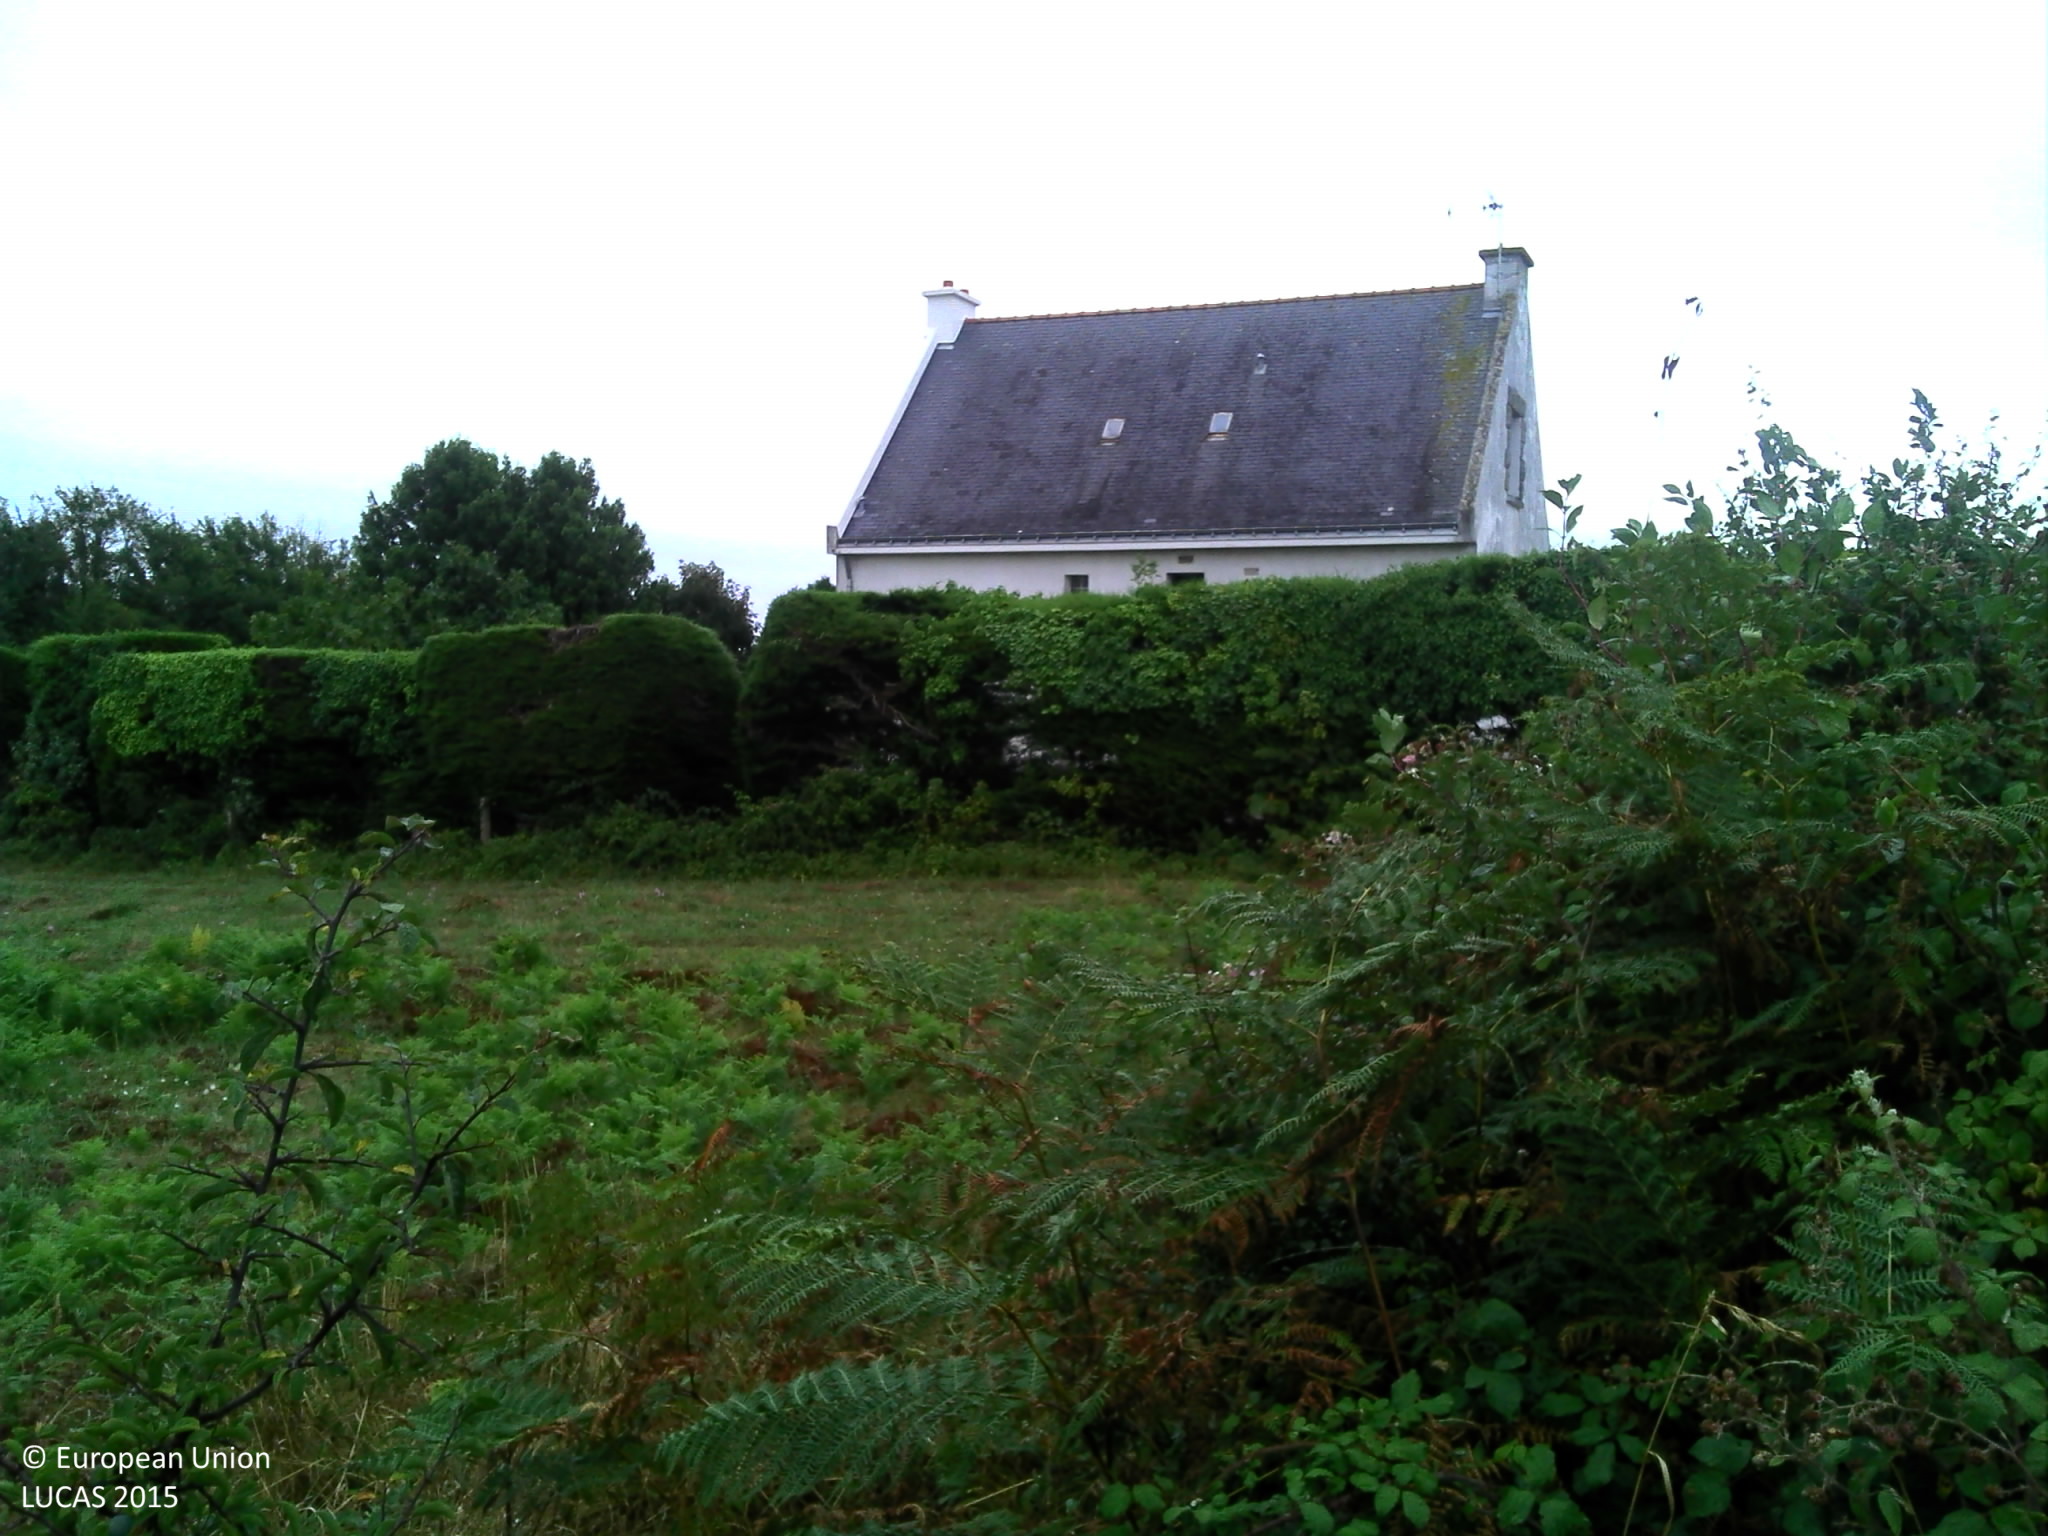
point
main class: Grassland
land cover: Grassland without tree/shrub cover
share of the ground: > 75 %
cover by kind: herbaceous plants 100 %
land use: Residential
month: July
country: FR
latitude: 47.7059
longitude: -3.4411
